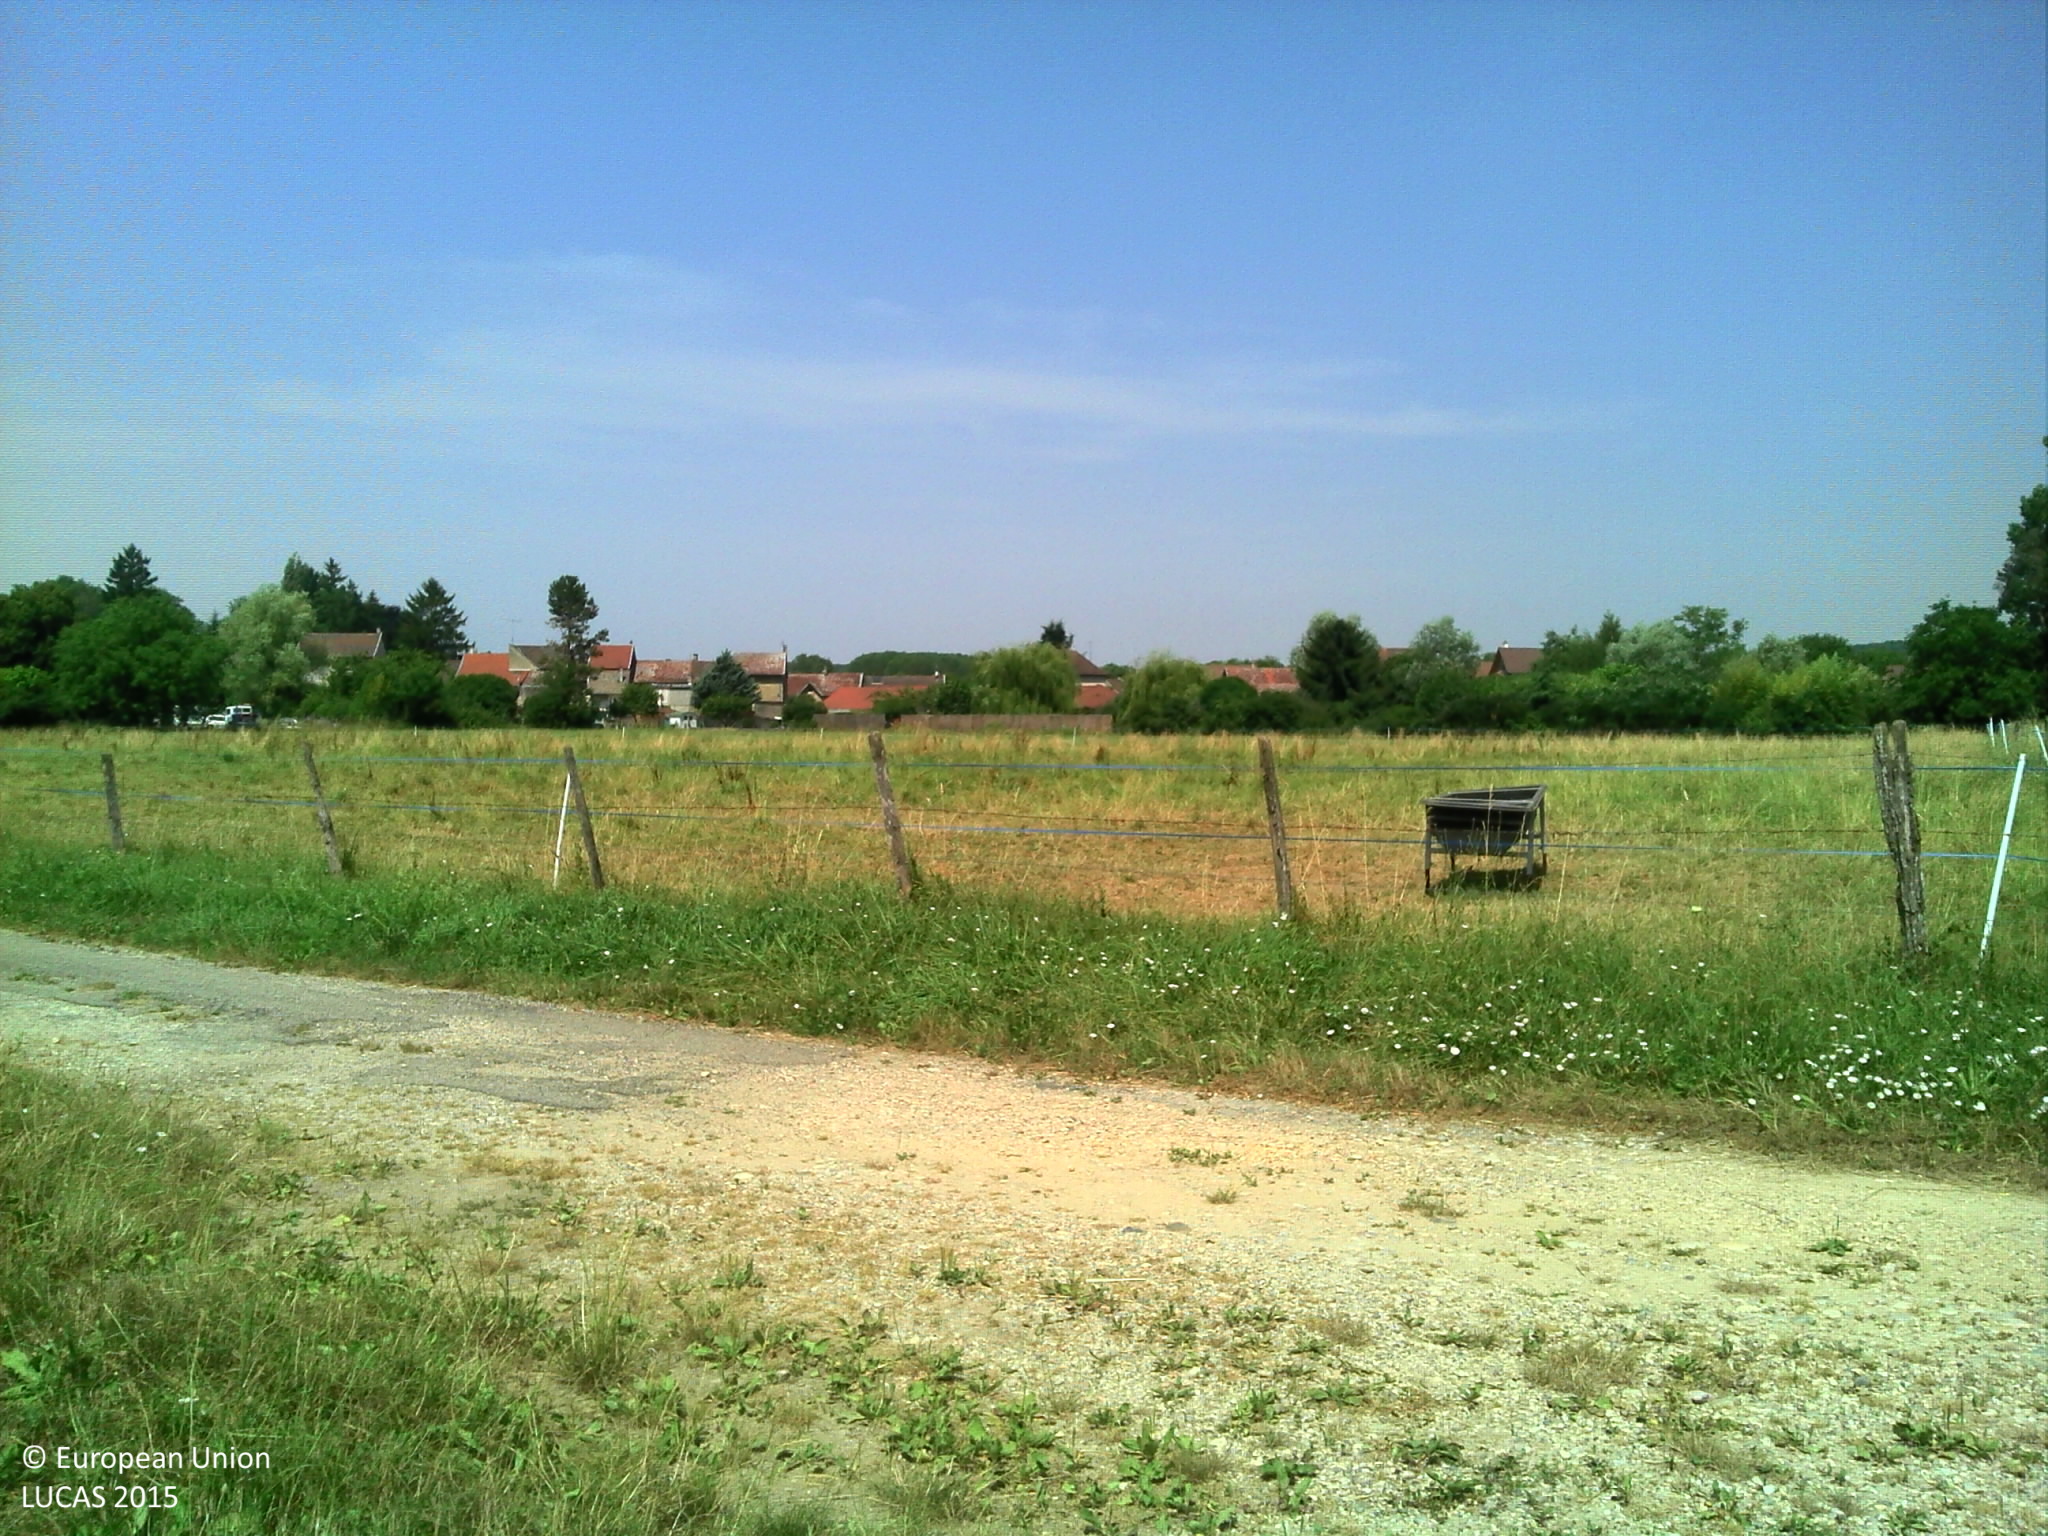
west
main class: Grassland
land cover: Grassland without tree/shrub cover
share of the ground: > 75 %
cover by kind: herbaceous plants 100 %
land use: Agriculture (excluding fallow land and kitchen gardens)
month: July
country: FR
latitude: 45.8197
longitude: 5.4091
